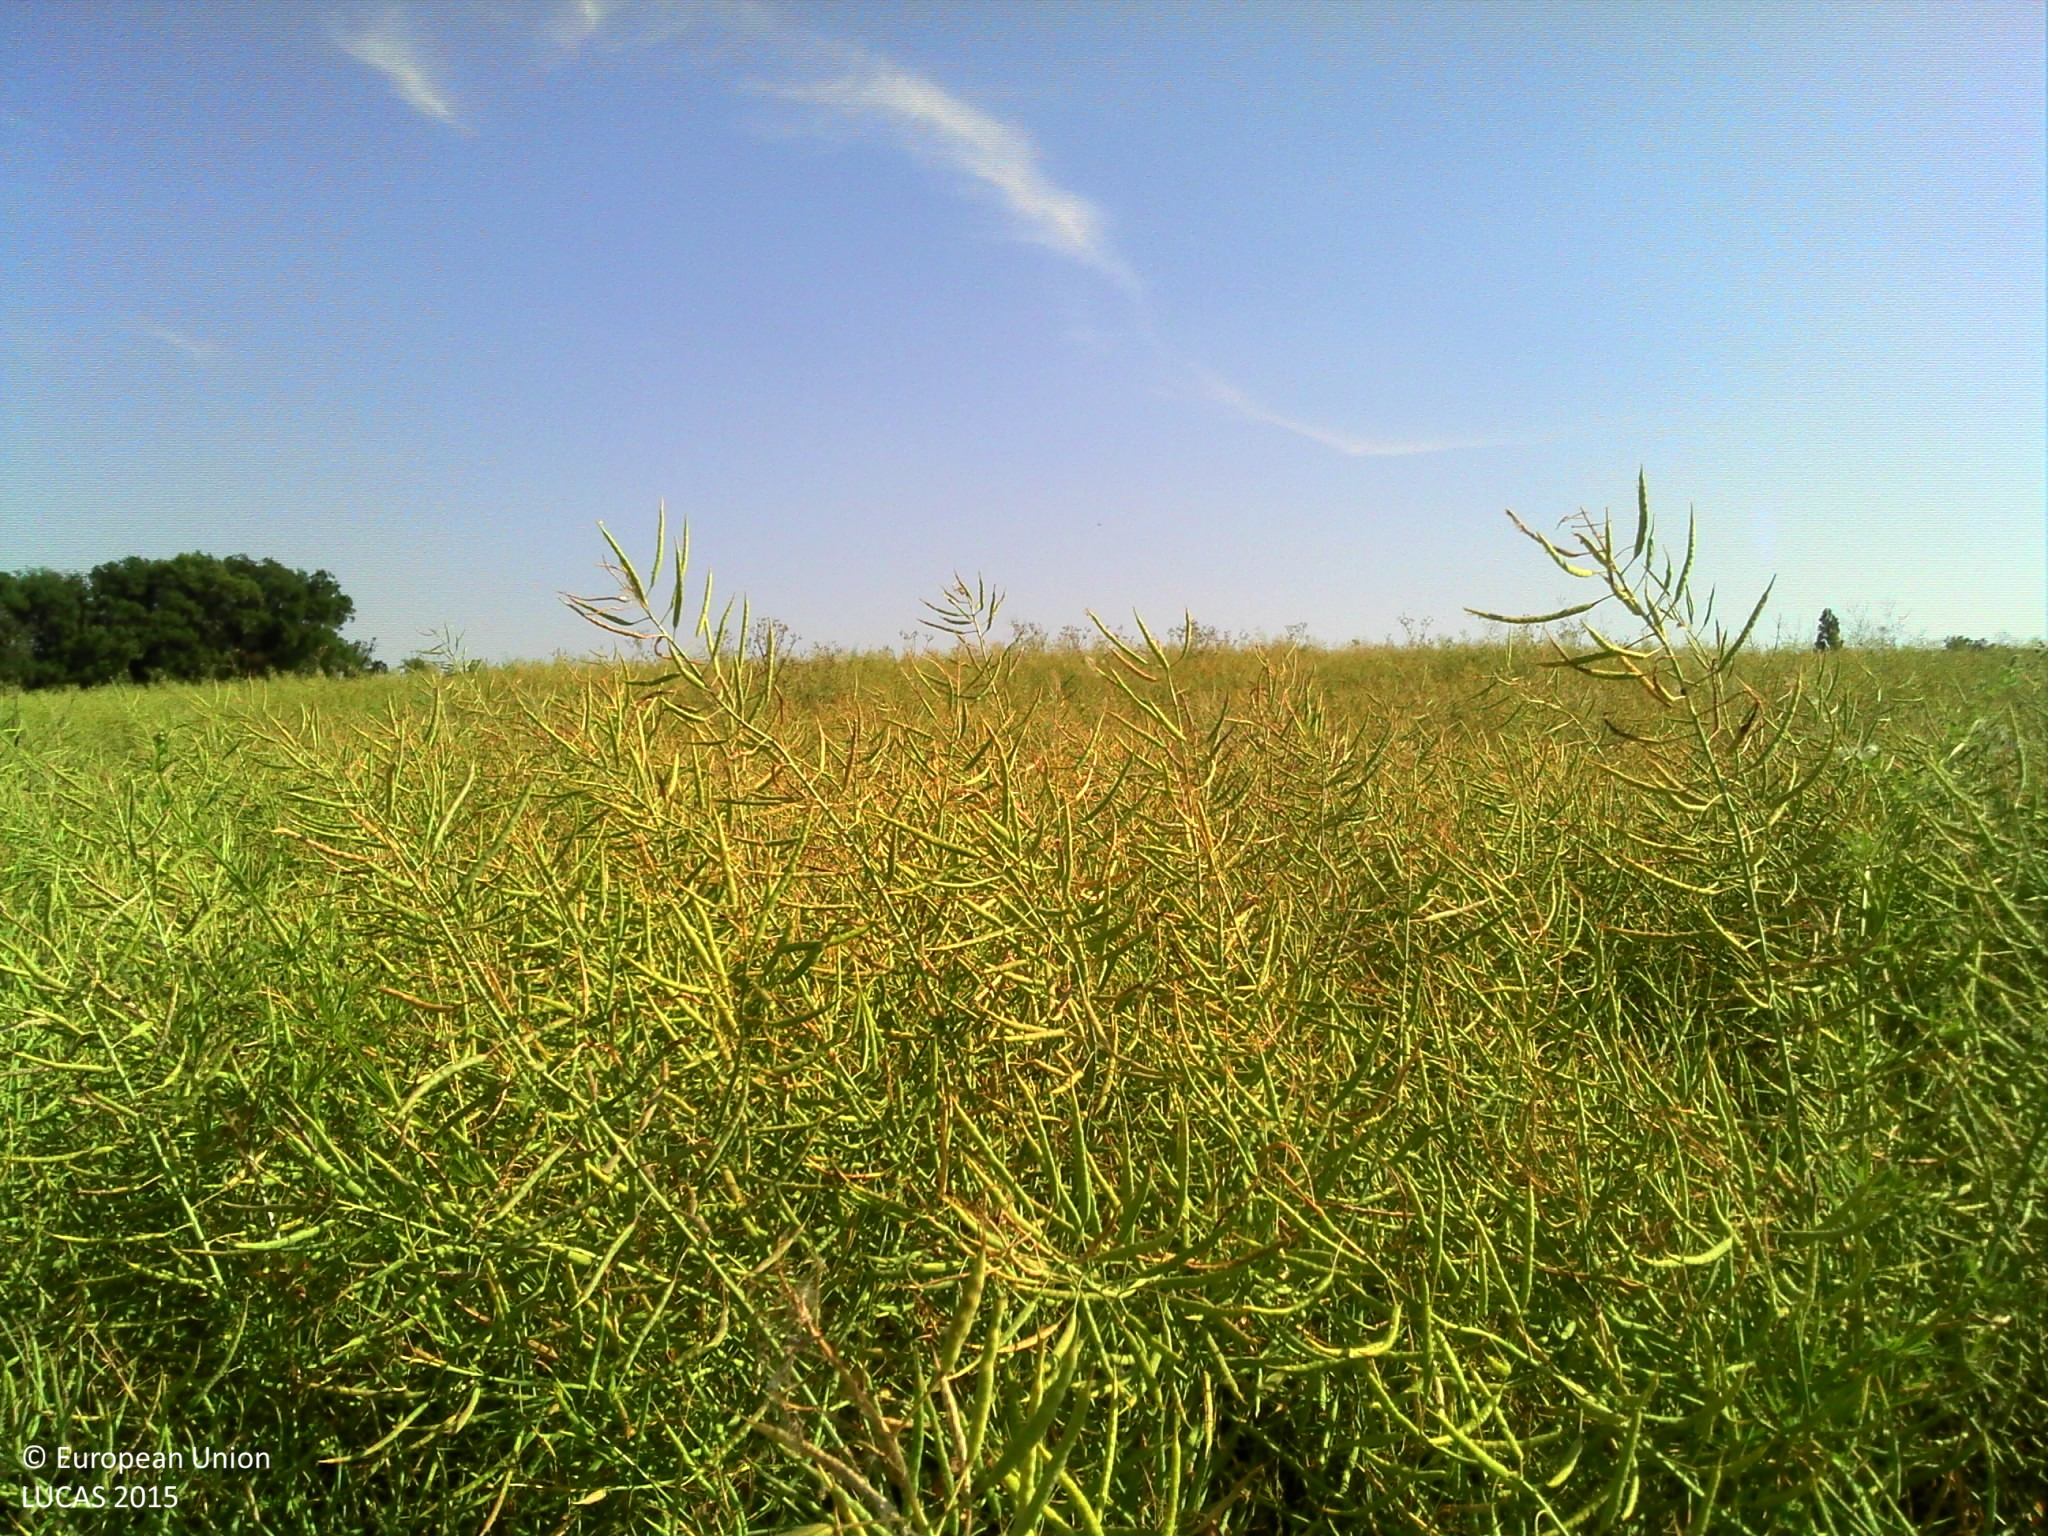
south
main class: Cropland
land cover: Rape and turnip rape
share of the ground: > 75 %
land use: Agriculture (excluding fallow land and kitchen gardens)
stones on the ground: < 10 %
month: June
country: FR
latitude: 43.6832
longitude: 0.7568
